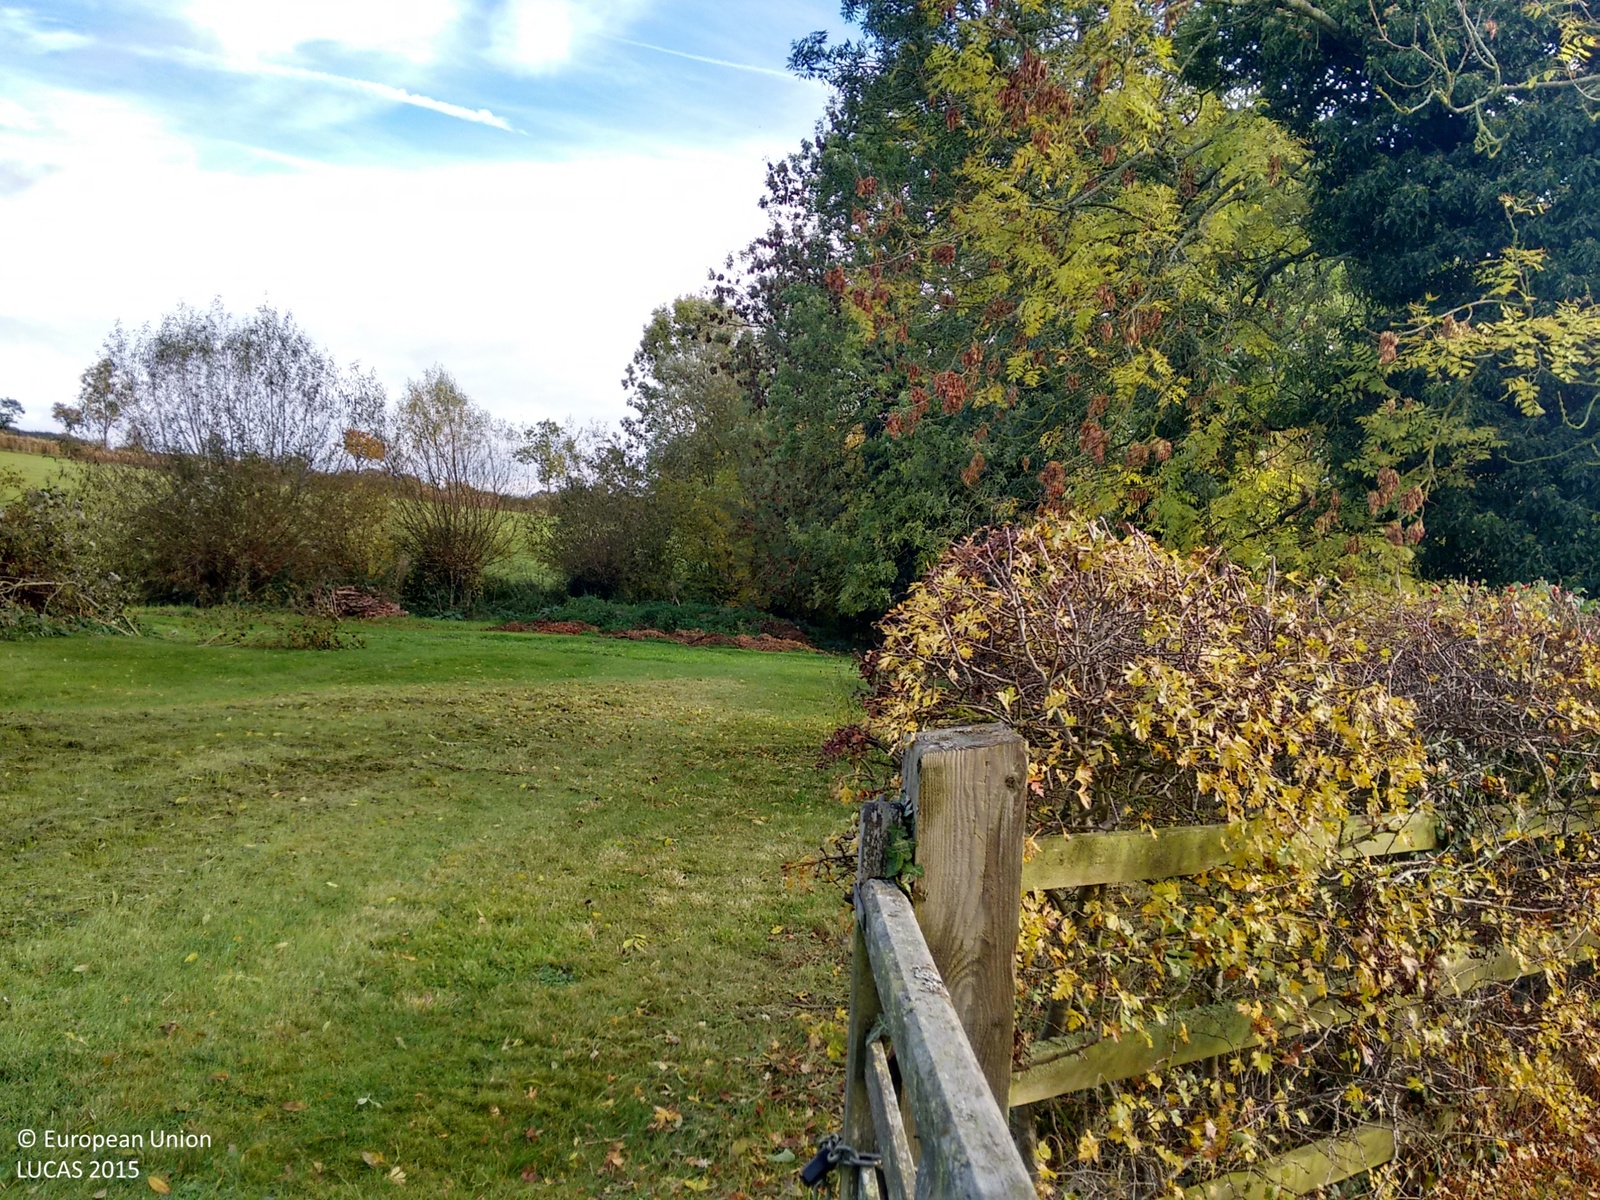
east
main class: Grassland
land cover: Grassland without tree/shrub cover
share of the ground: > 75 %
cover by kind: herbaceous plants 100 %
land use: Agriculture (excluding fallow land and kitchen gardens)
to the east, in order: Grassland without tree/shrub cover; Lines of trees; Managed hedges; Grass margins; Paved roads, cycling and walking lanes; Electric lines; Managed hedges; Grass margins; Other bare soil
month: October
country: GB
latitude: 52.0505
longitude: -1.7053
